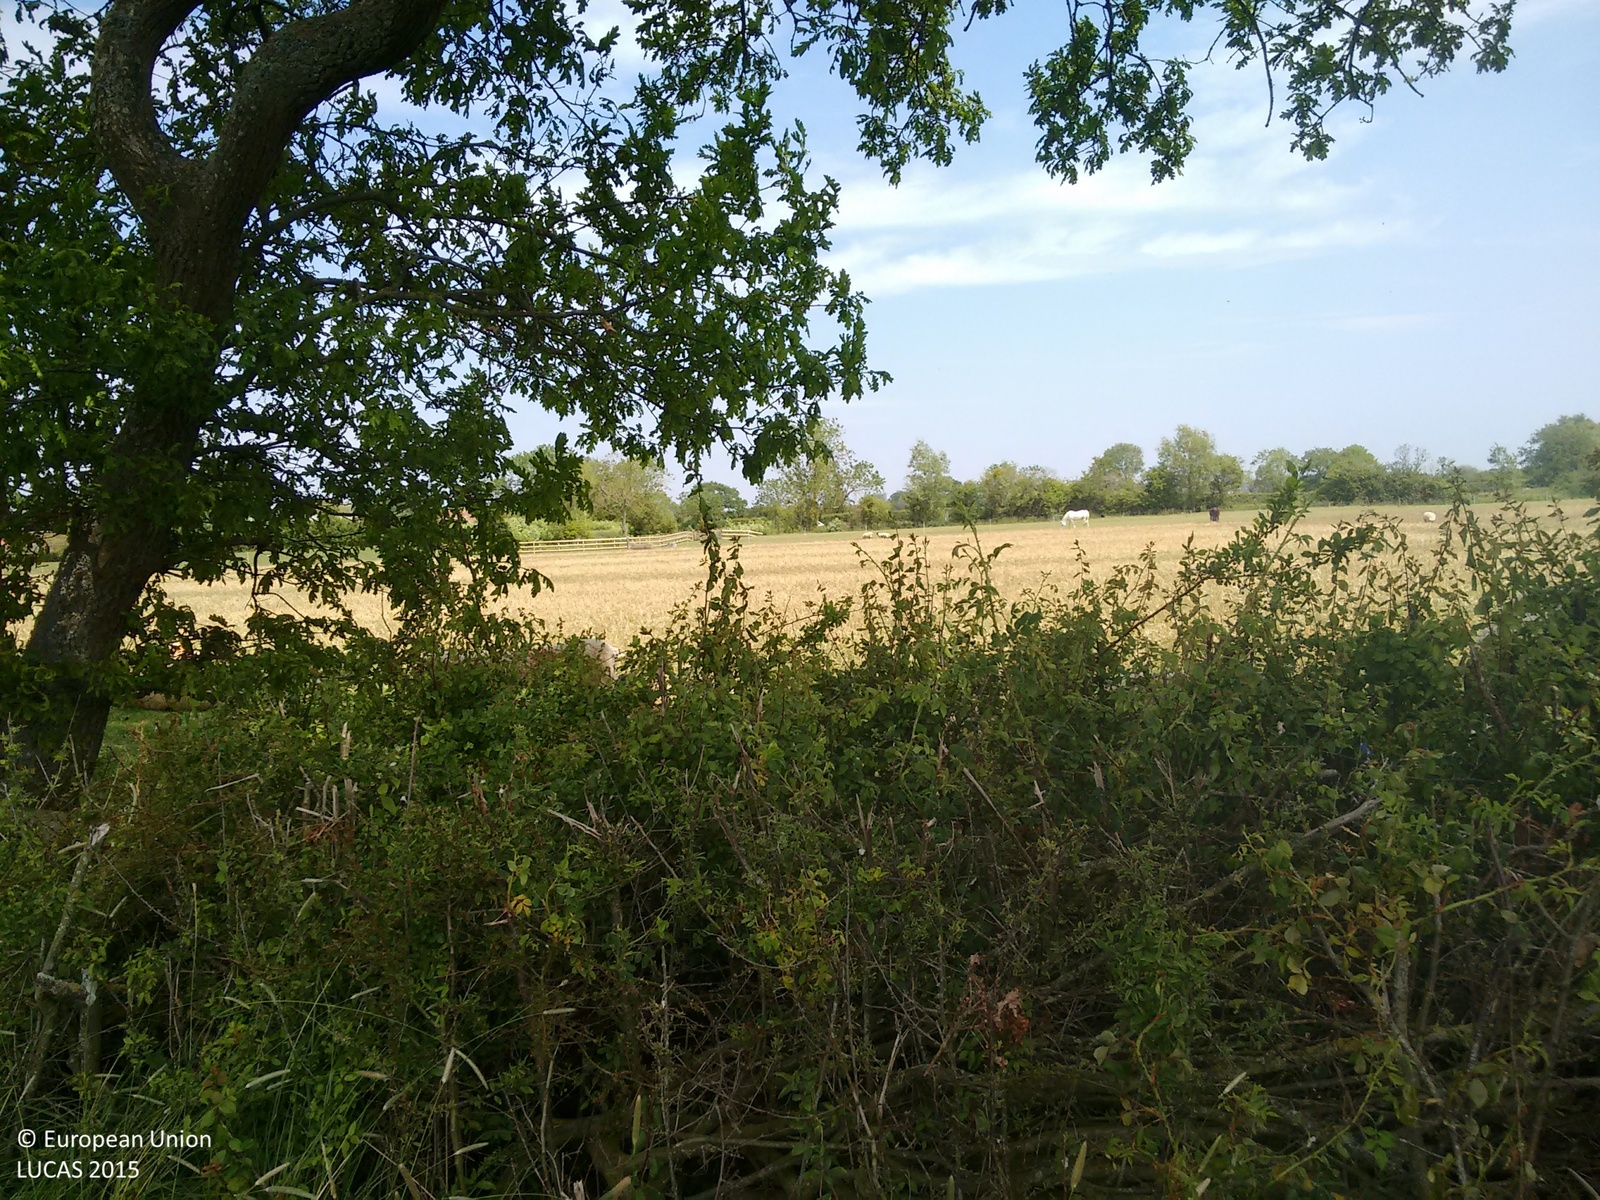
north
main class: Cropland
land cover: Common wheat
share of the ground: > 75 %
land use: Agriculture (excluding fallow land and kitchen gardens)
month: June
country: GB
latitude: 51.0072
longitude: -2.7983
